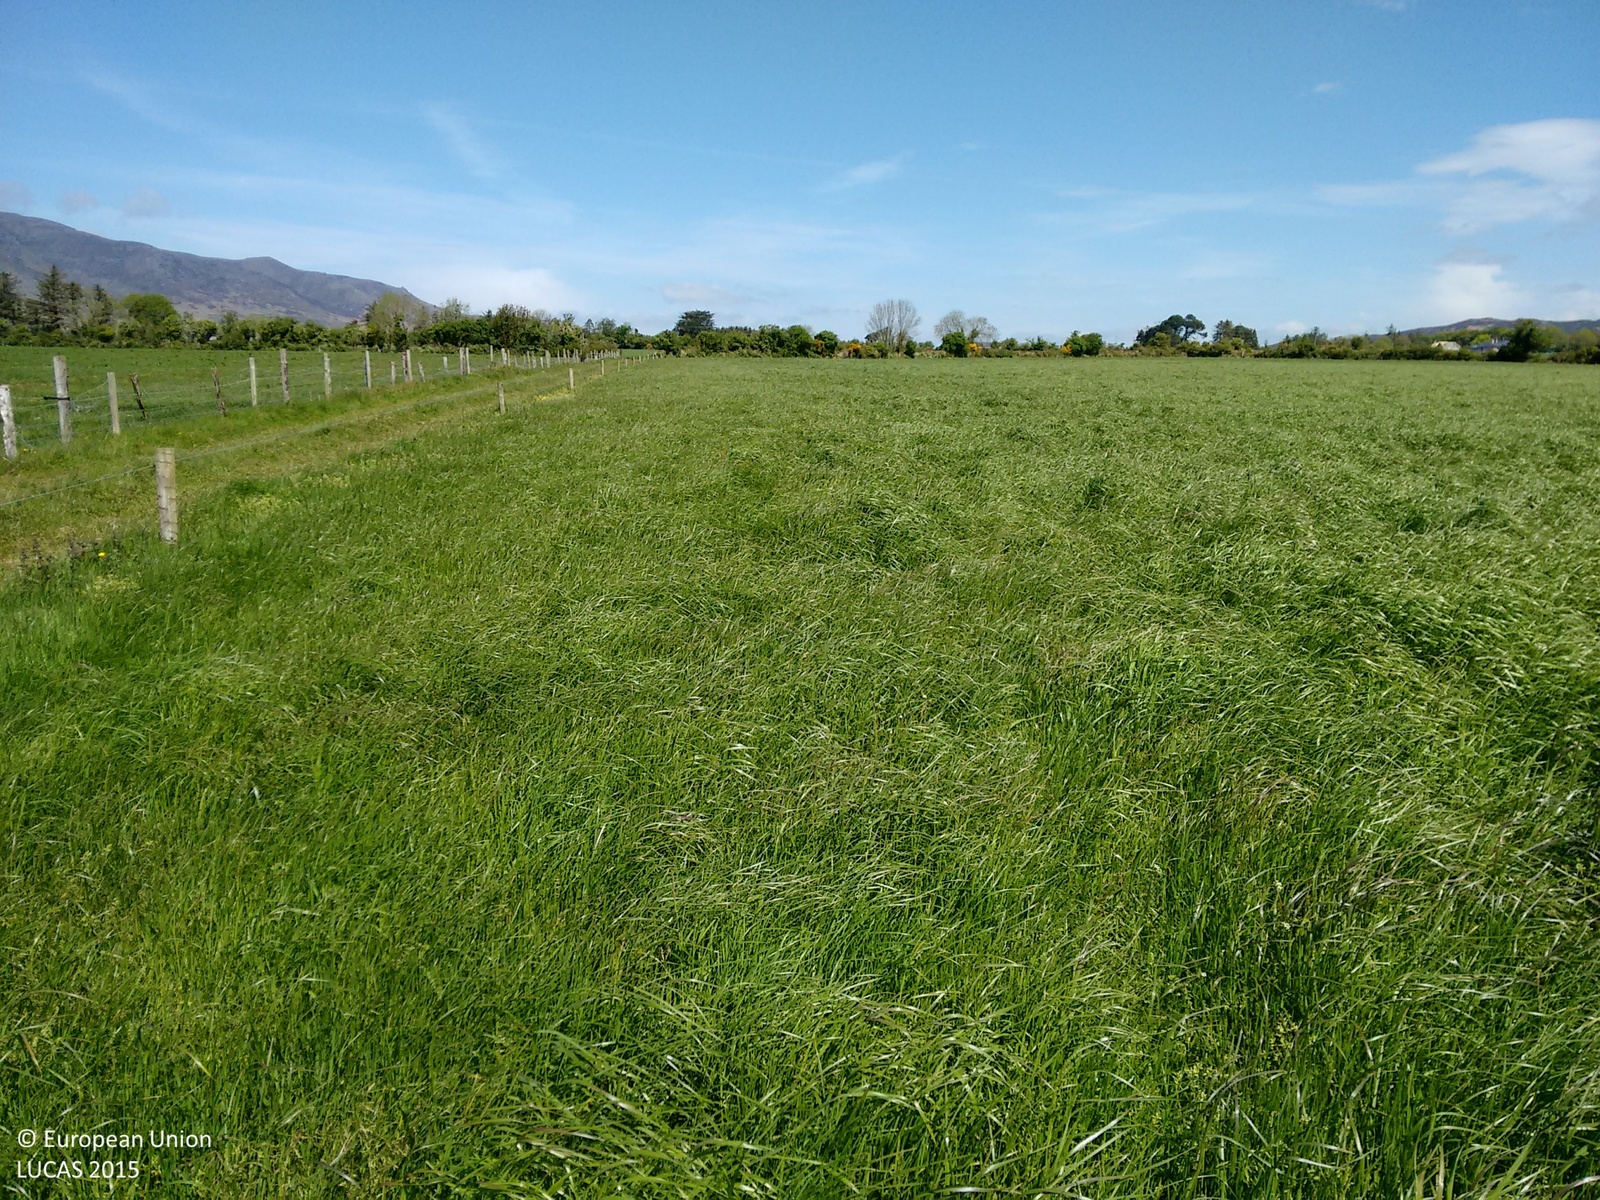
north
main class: Grassland
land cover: Grassland without tree/shrub cover
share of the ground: > 75 %
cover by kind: herbaceous plants 100 %
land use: Agriculture (excluding fallow land and kitchen gardens)
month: May
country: IE
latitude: 52.2091
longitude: -7.4704
